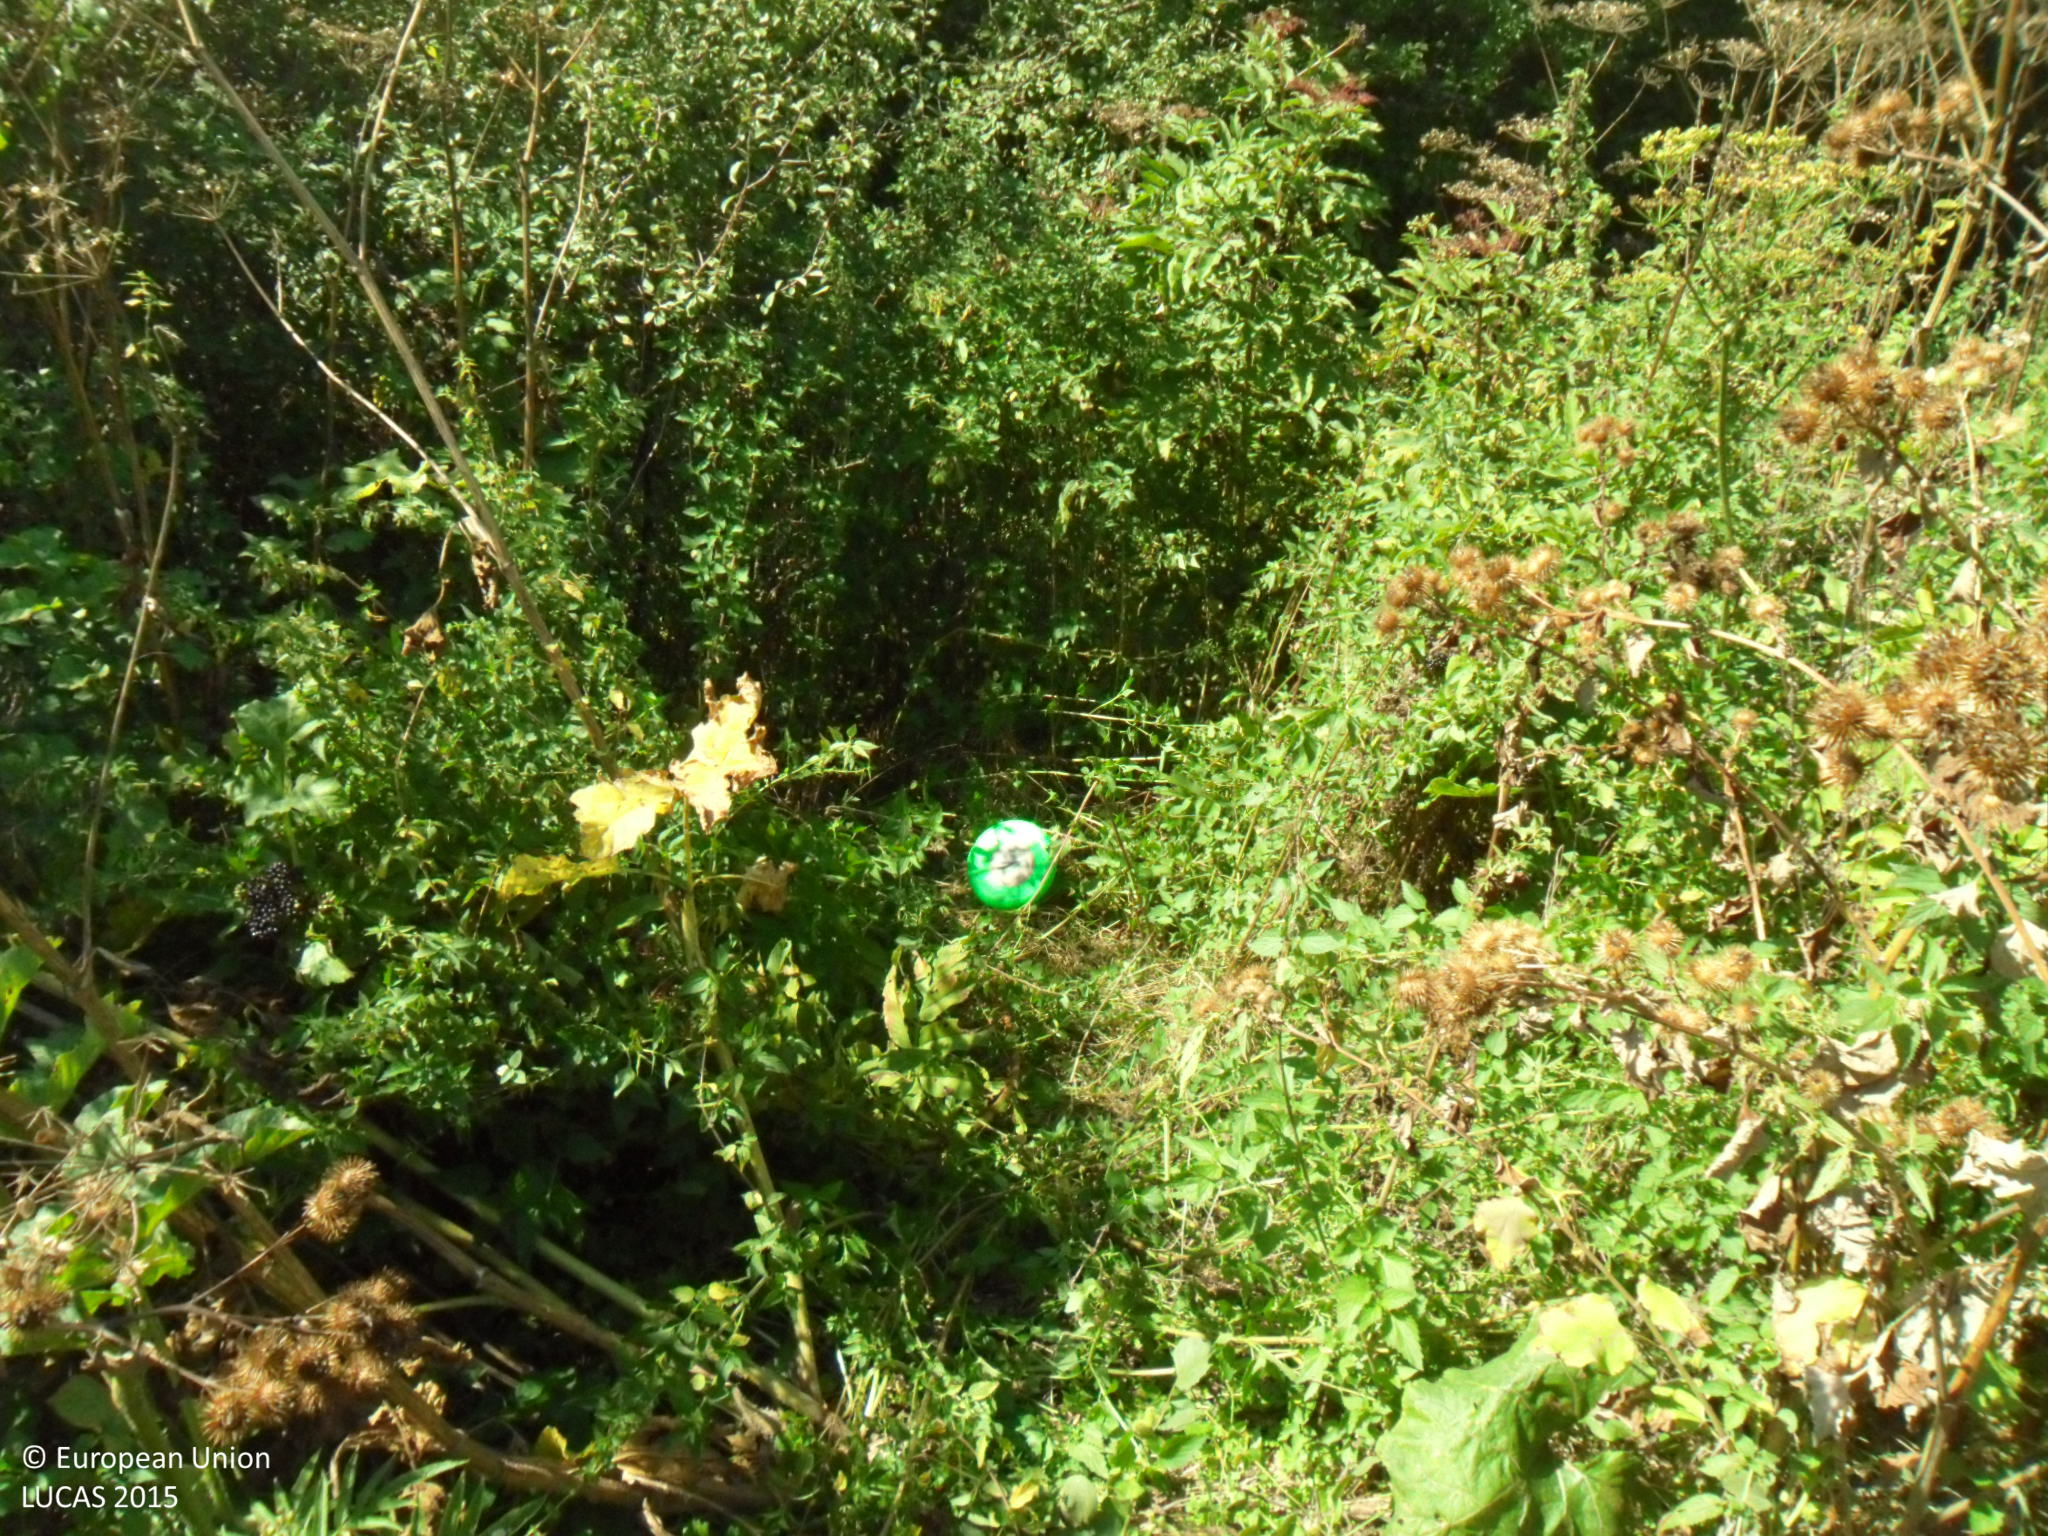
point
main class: Shrubland
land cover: Shrubland with sparse tree cover
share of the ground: > 75 %
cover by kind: shrubs 95 %, broadleaved forest trees 5 %
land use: Forestry
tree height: > 5 m
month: September
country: BG
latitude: 43.6644
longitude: 27.1502
